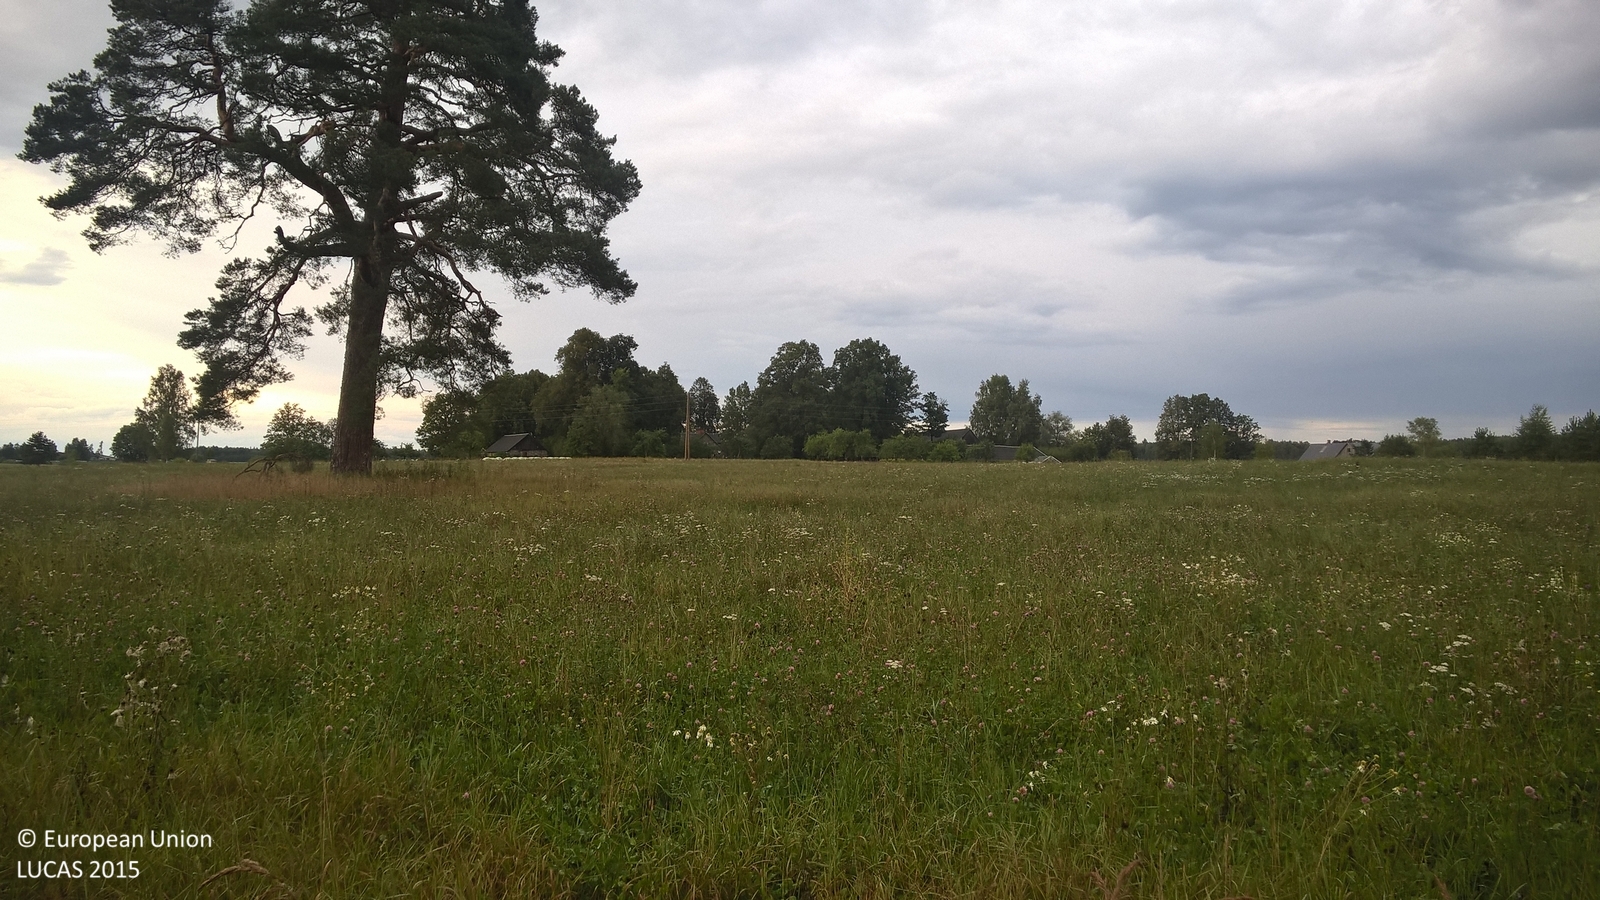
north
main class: Woodland
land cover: Broadleaved woodland
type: non-riverine alder, birch or aspen forest
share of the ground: 50 - 75 %
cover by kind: broadleaved forest trees 70 %, herbaceous plants 30 %
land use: Forestry
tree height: < 5 m
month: September
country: LV
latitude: 57.3676
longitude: 25.4957
